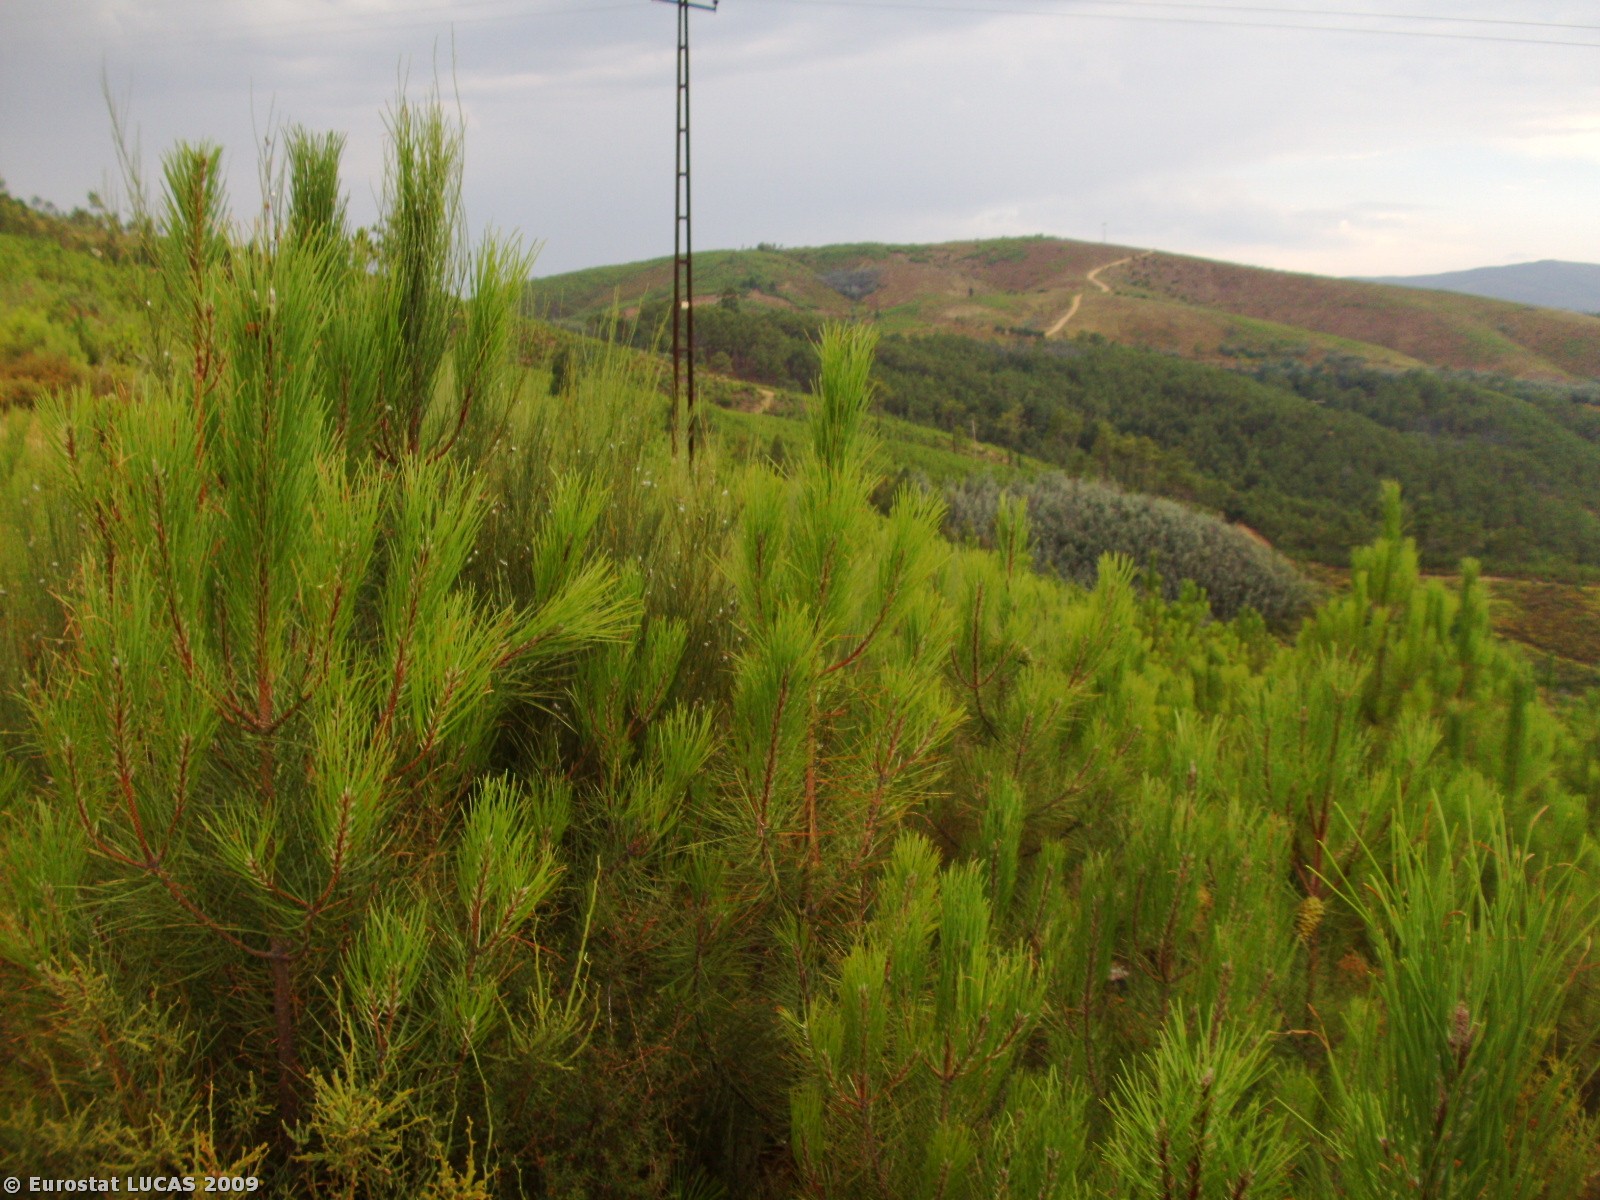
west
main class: Woodland
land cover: Coniferous woodland
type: coniferous forest of the mediterranean region
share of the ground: > 75 %
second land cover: Shrubland with sparse tree cover
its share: 10 - 25 %
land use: Forestry
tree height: > 5 m
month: August
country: PT
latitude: 40.1252
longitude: -7.6758
